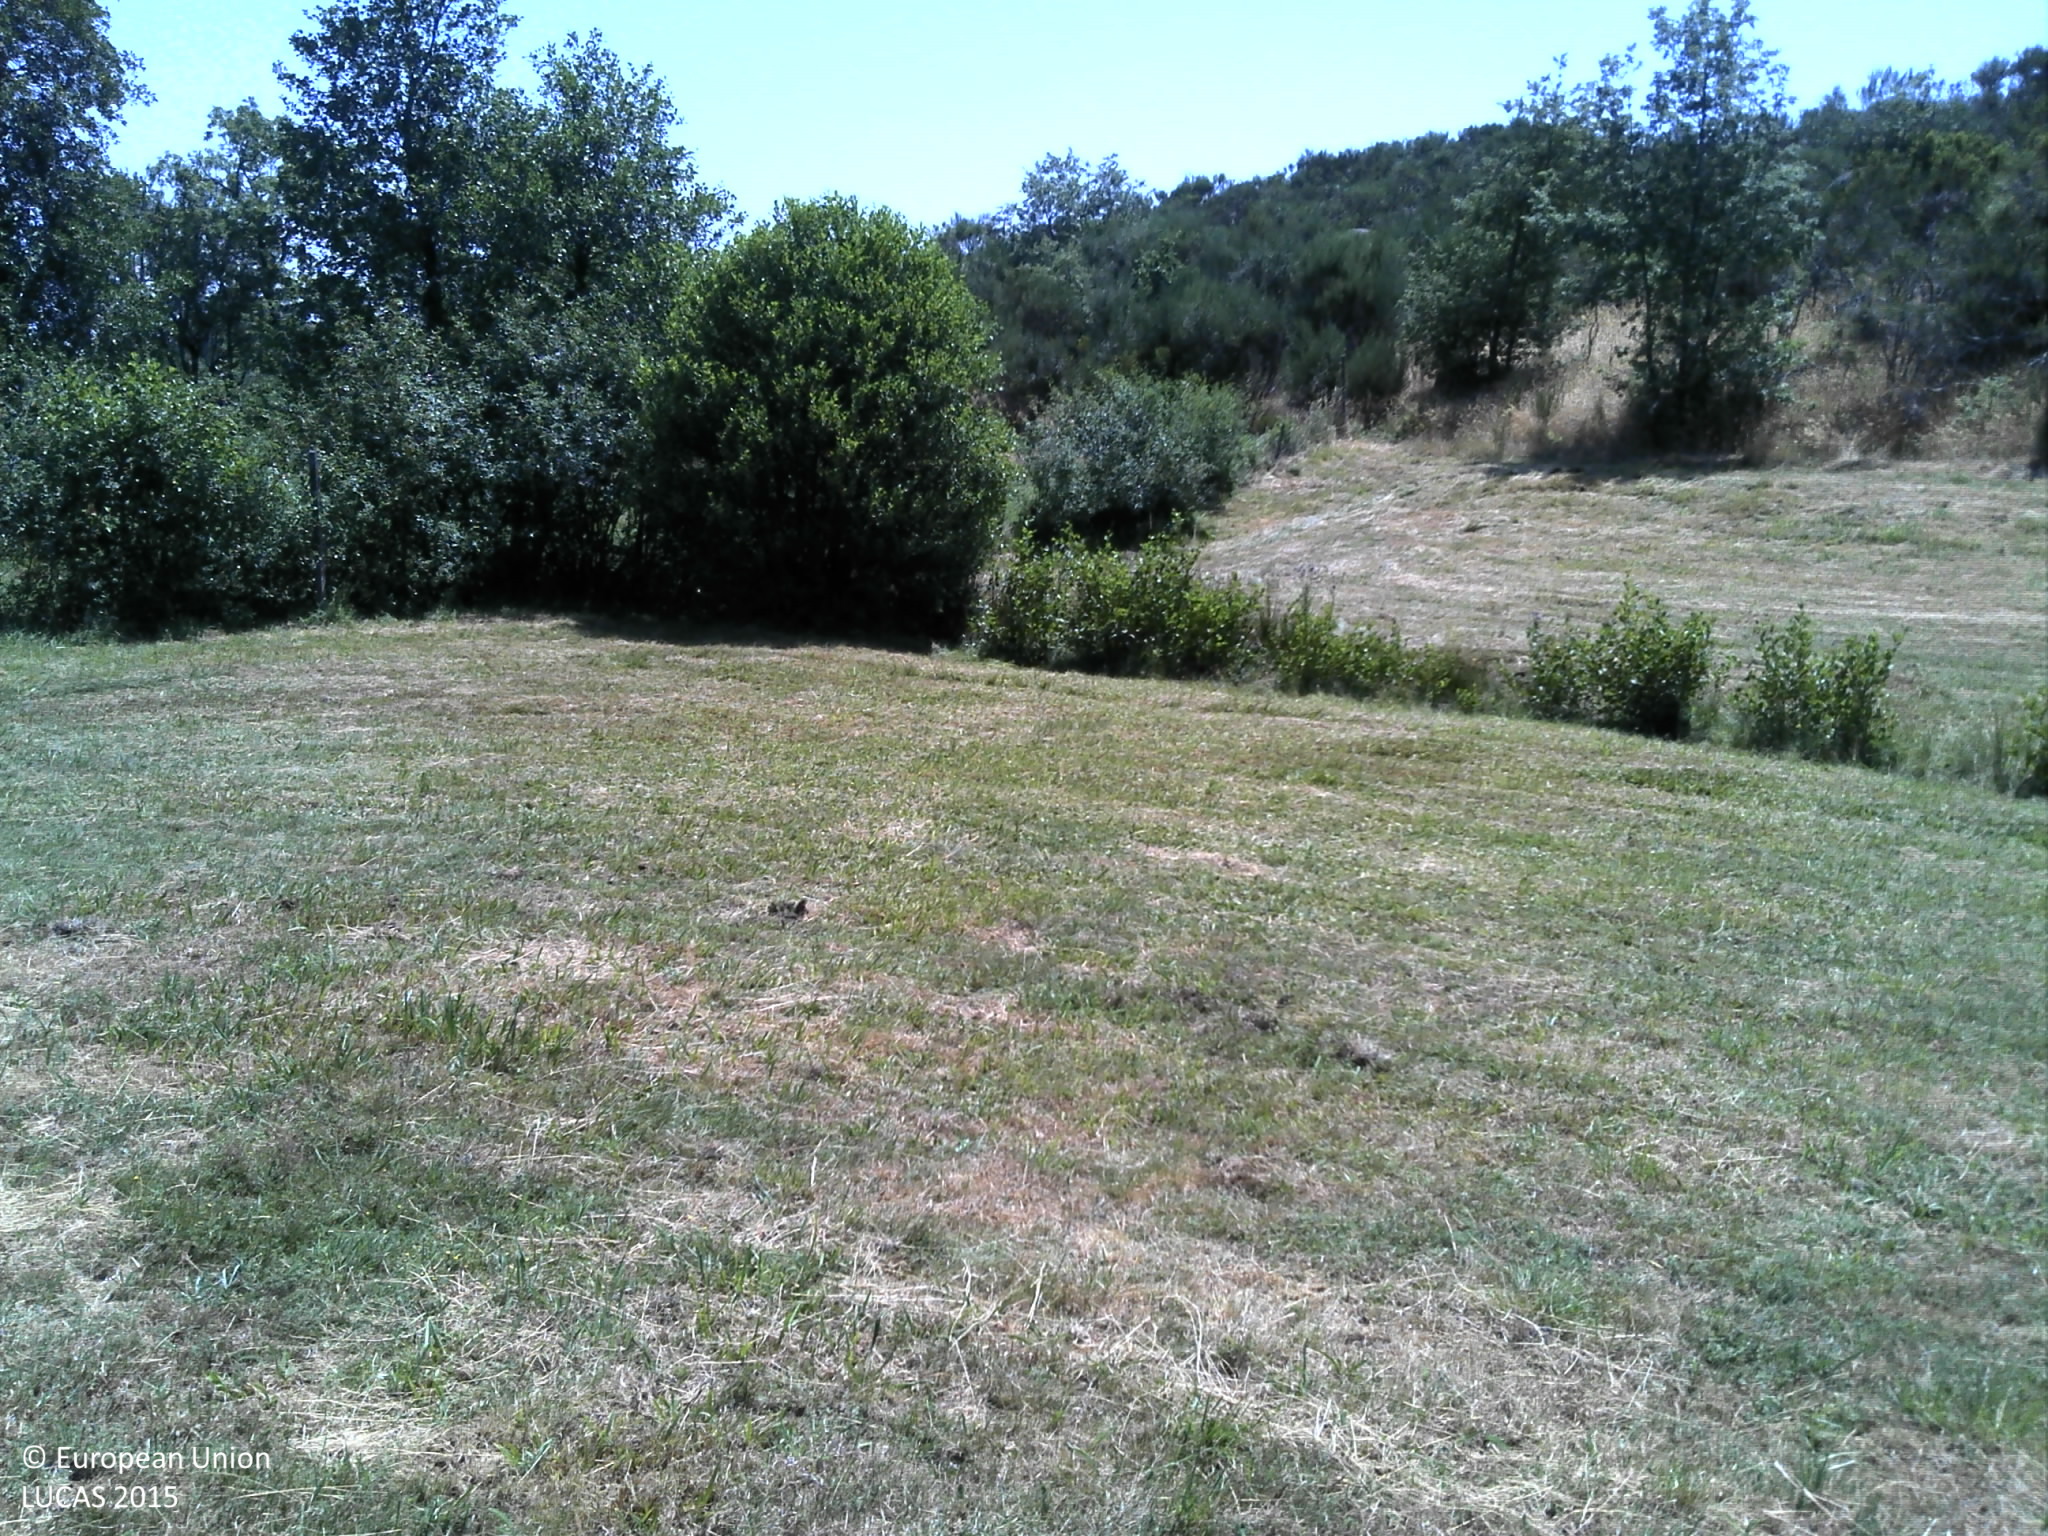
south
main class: Grassland
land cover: Grassland without tree/shrub cover
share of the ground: > 75 %
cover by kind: herbaceous plants 75 %, unconsolidated bare surface 25 %
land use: Agriculture (excluding fallow land and kitchen gardens)
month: July
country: PT
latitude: 40.9754
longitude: -7.8716
